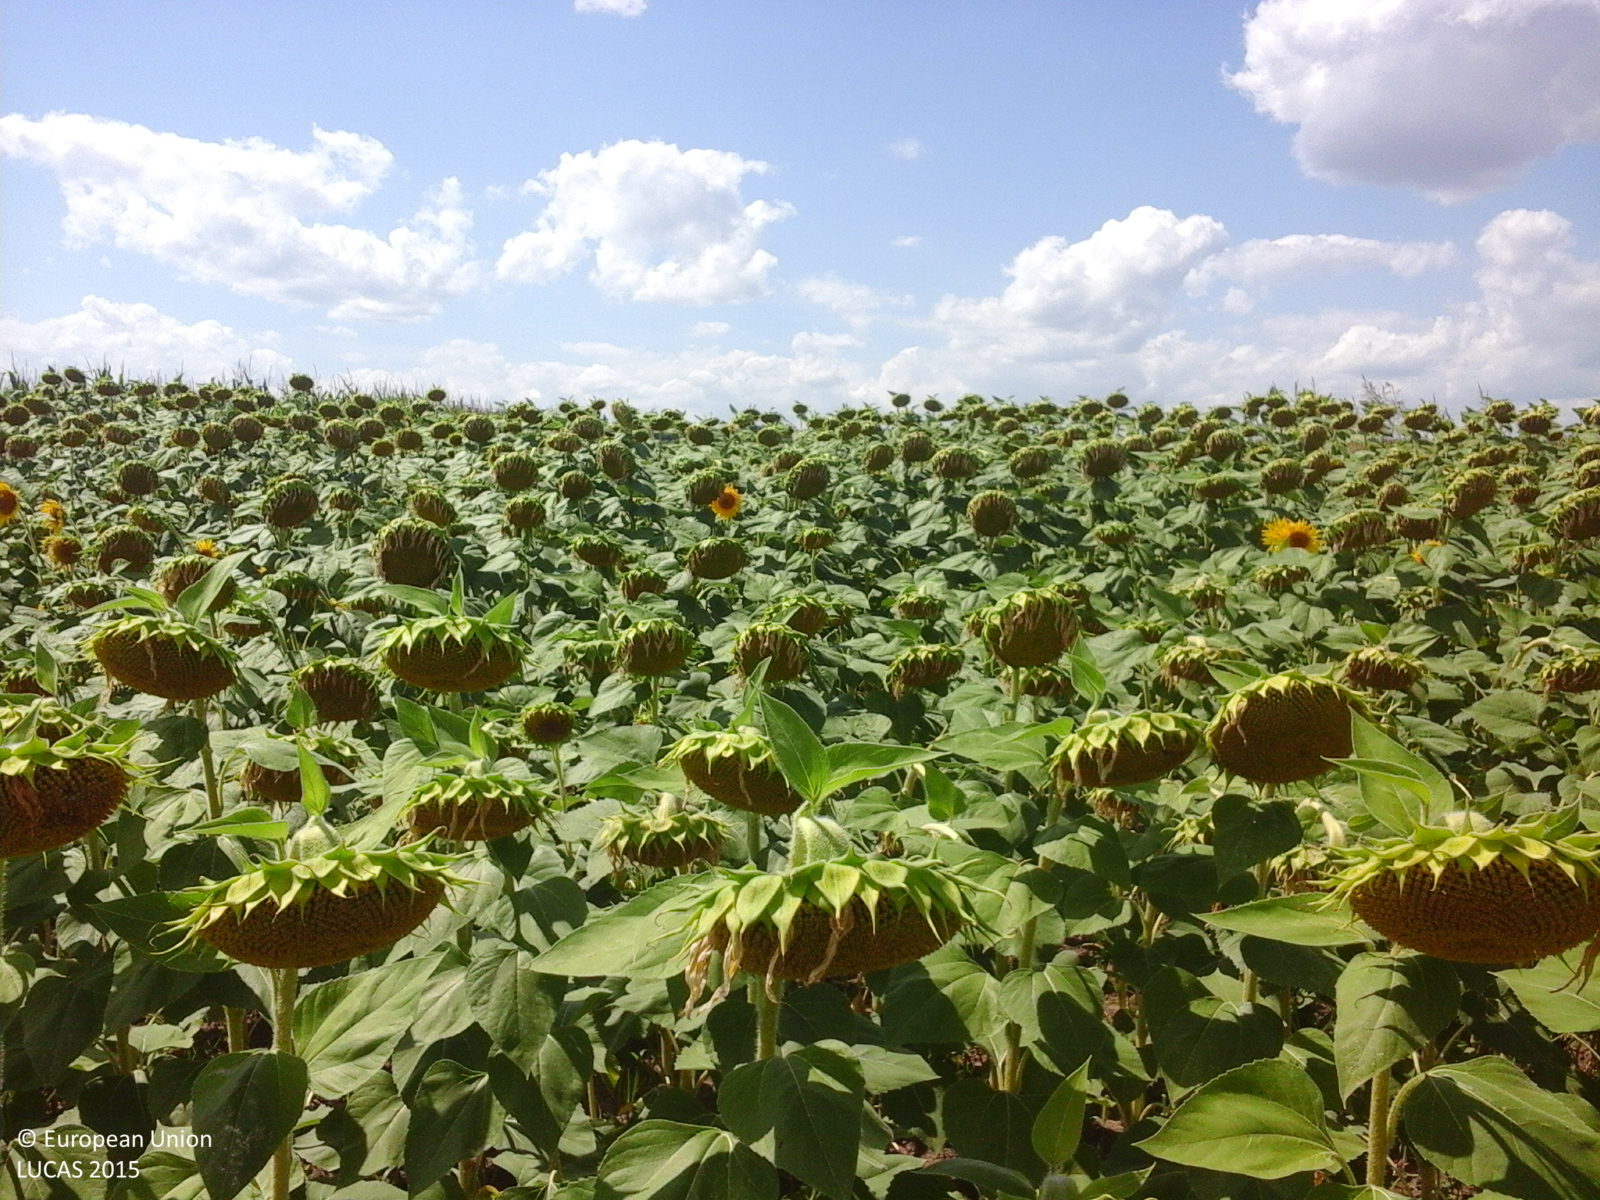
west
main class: Cropland
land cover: Sunflower
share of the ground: > 75 %
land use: Agriculture (excluding fallow land and kitchen gardens)
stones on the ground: < 10 %
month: July
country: RO
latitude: 46.4356
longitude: 28.1836
